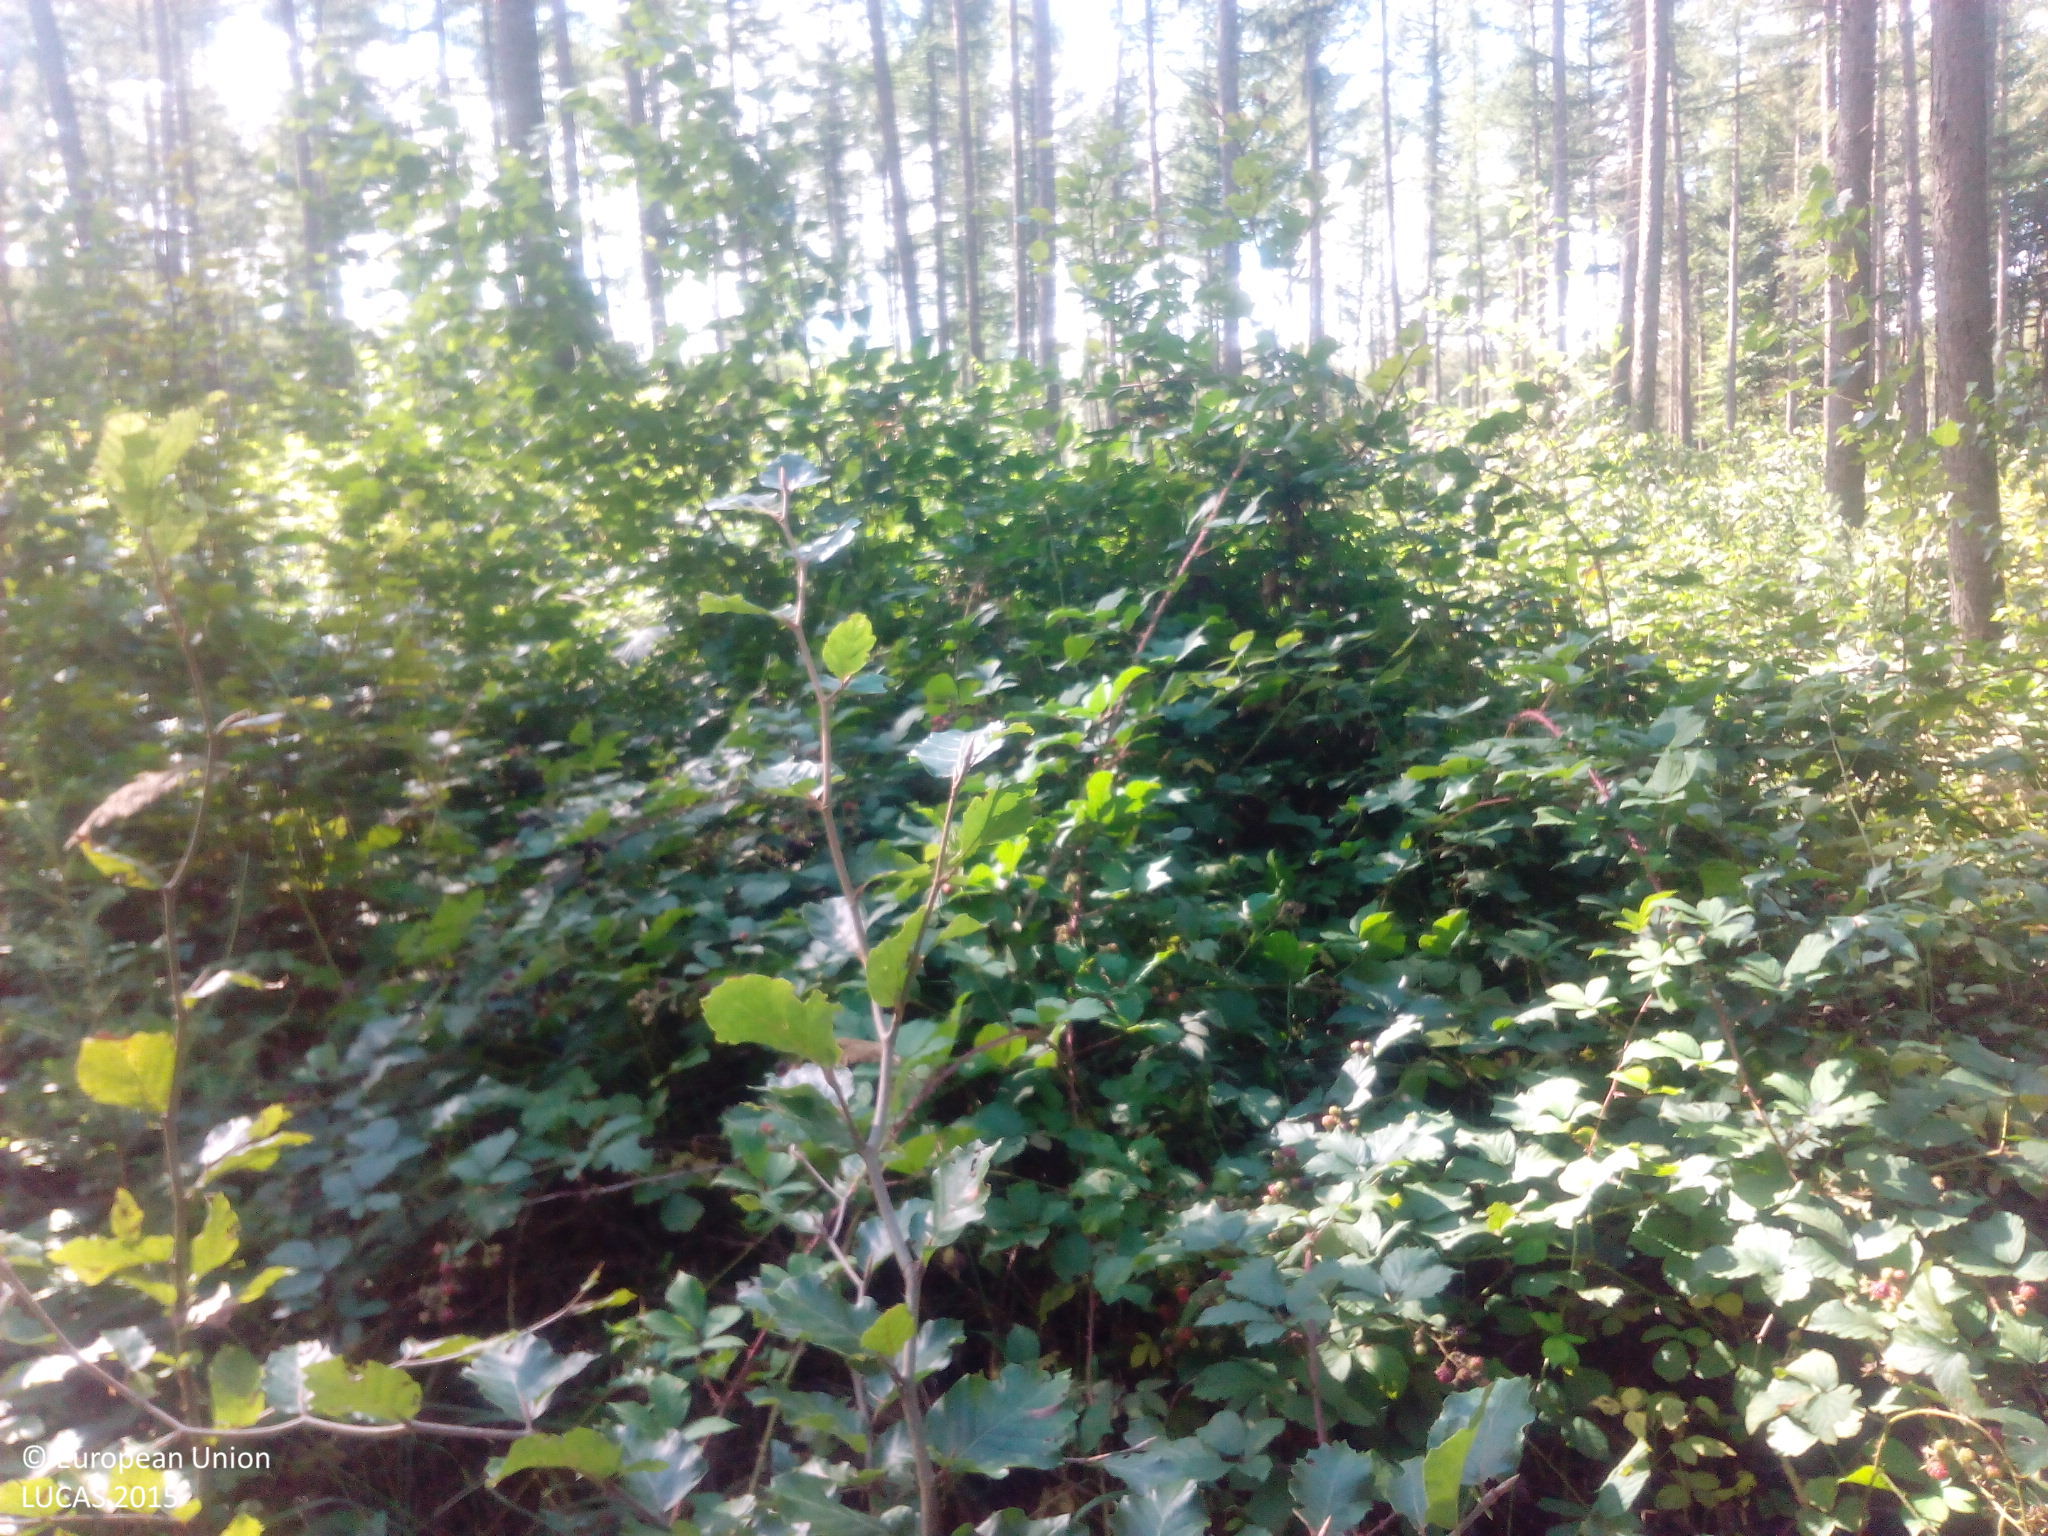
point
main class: Woodland
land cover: Other mixed woodland
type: hemiboreal forest and nemoral coniferous forest and mixed broadleaved-coniferous forest
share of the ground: > 75 %
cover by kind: coniferous forest trees 70 %, broadleaved forest trees 25 %, shrubs 5 %
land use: Forestry
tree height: > 5 m
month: September
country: DE
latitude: 54.1171
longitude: 12.3091
